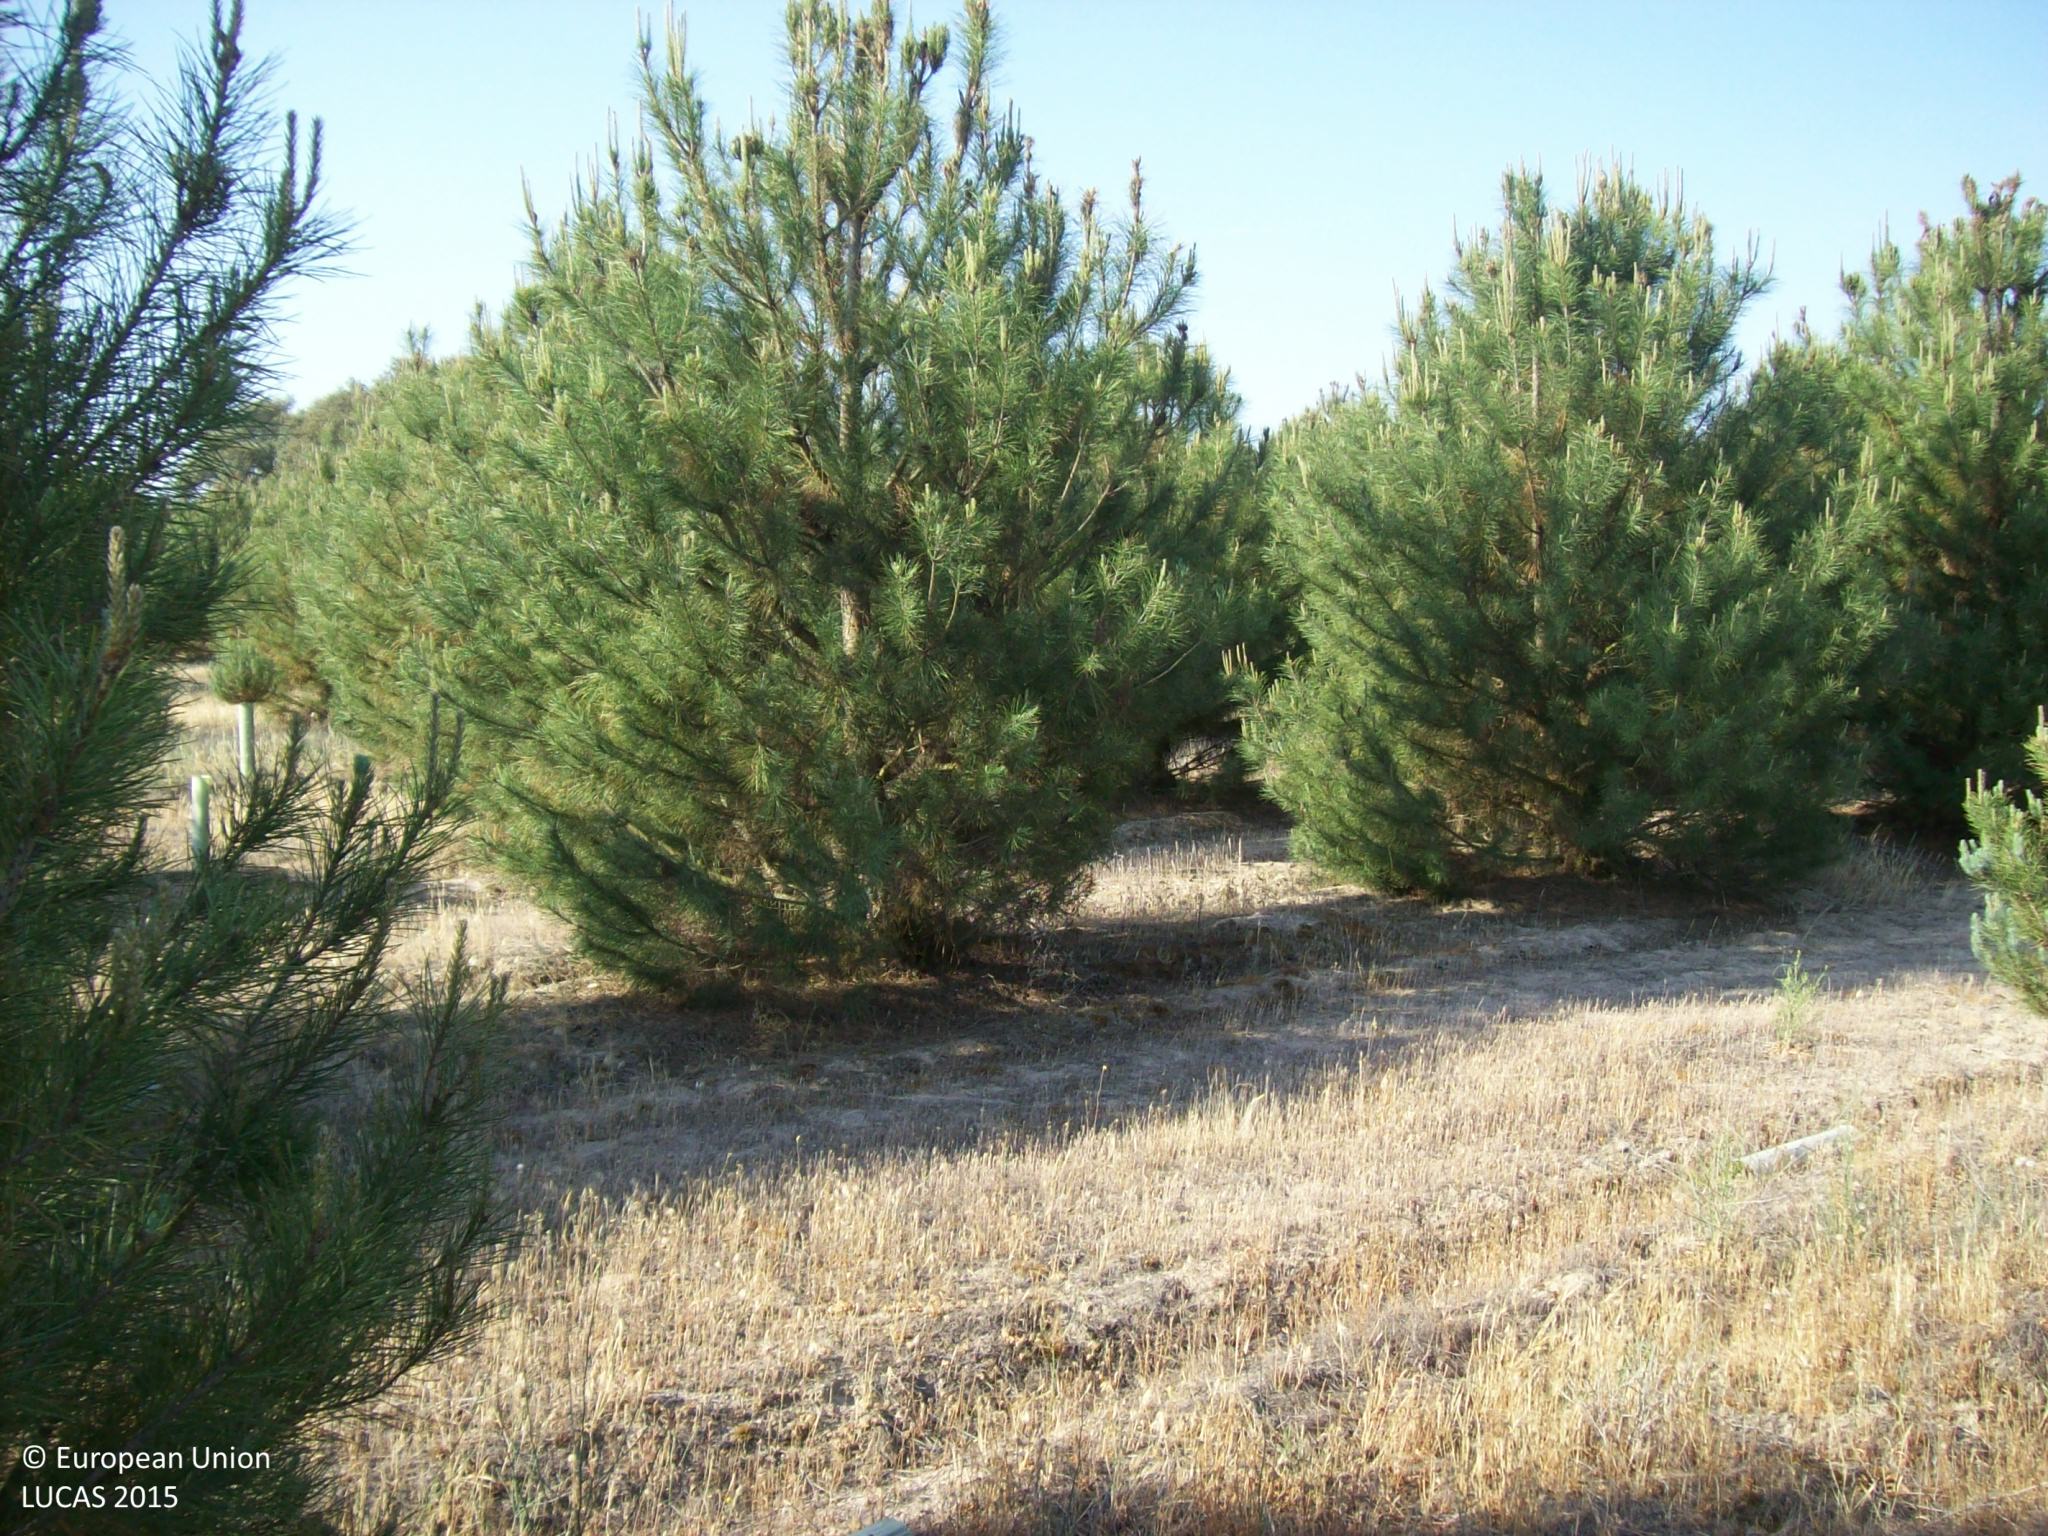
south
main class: Woodland
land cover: Pine dominated coniferous woodland
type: coniferous forest of the mediterranean region
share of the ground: 25 - 50 %
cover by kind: herbaceous plants 60 %, coniferous forest trees 35 %, broadleaved forest trees 5 %
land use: Forestry
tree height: < 5 m
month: June
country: ES
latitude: 41.1697
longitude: -5.0752
